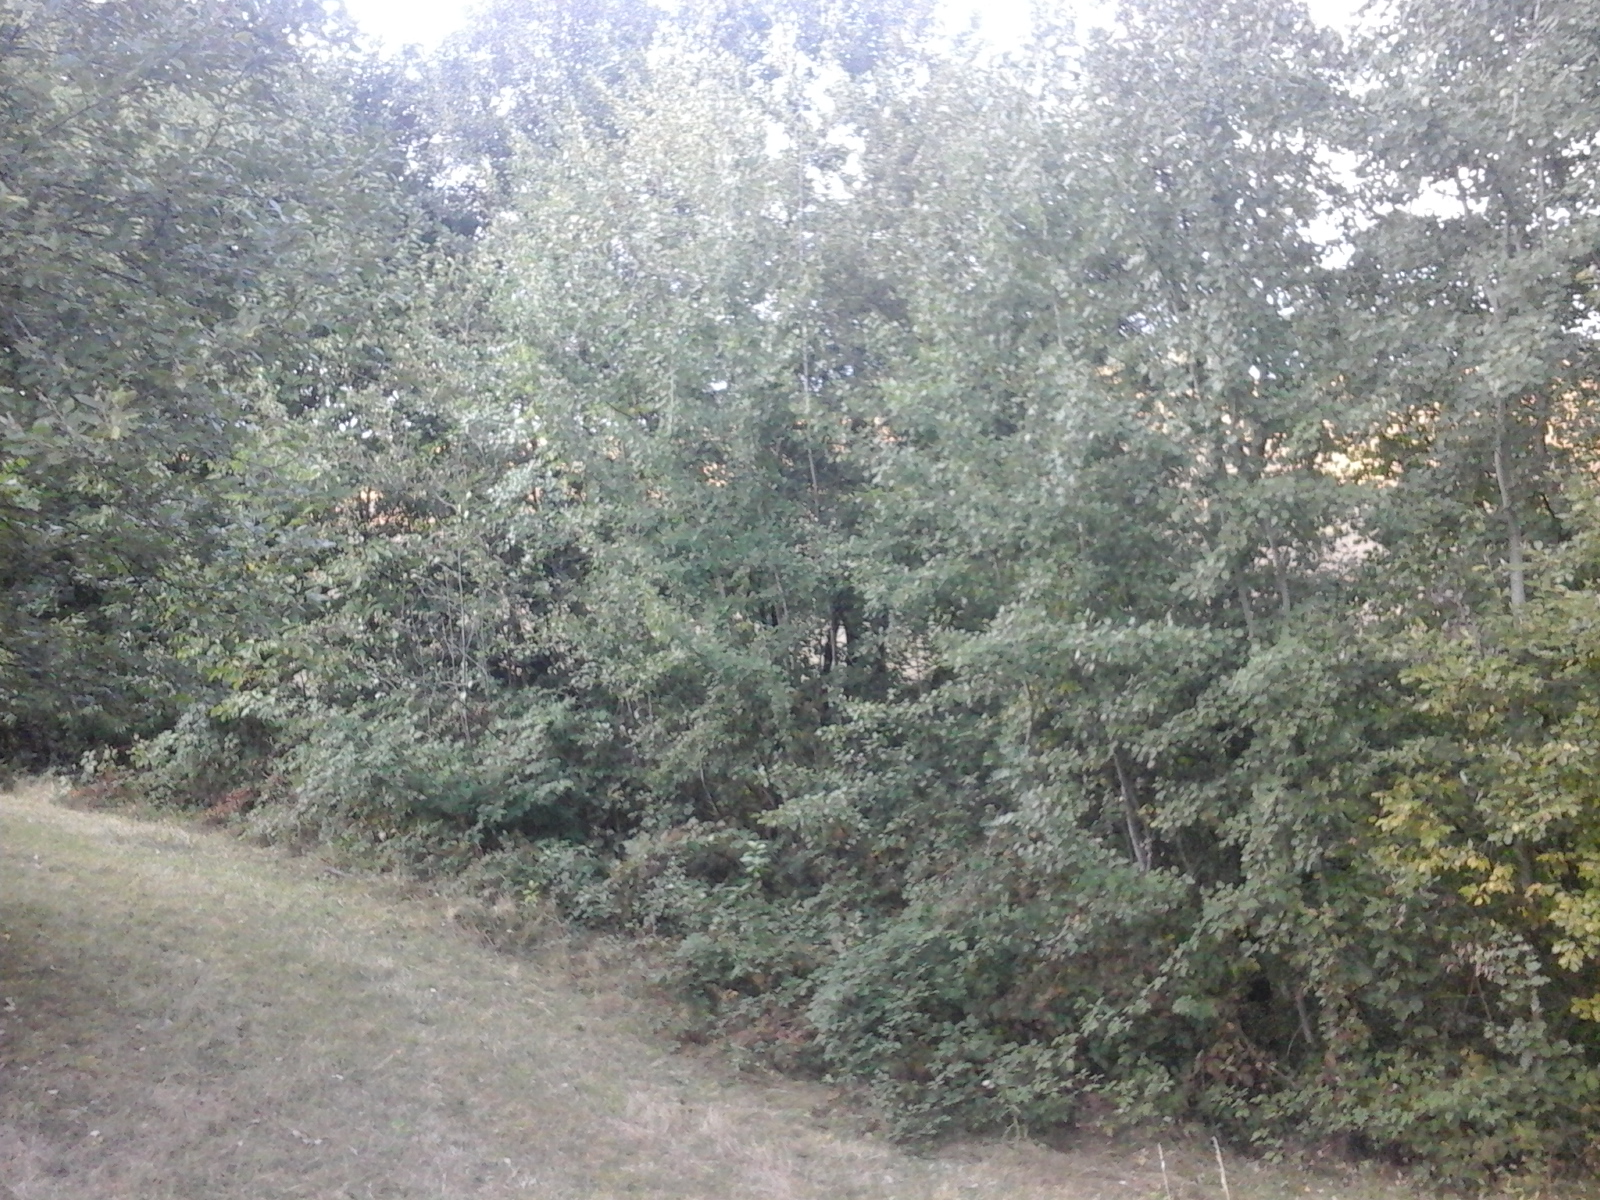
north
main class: Cropland
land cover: Other fruit trees and berries
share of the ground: > 75 %
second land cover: Grassland without tree/shrub cover
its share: > 75 %
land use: Agriculture (excluding fallow land and kitchen gardens)
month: September
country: RO
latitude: 47.4678
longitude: 23.5945
